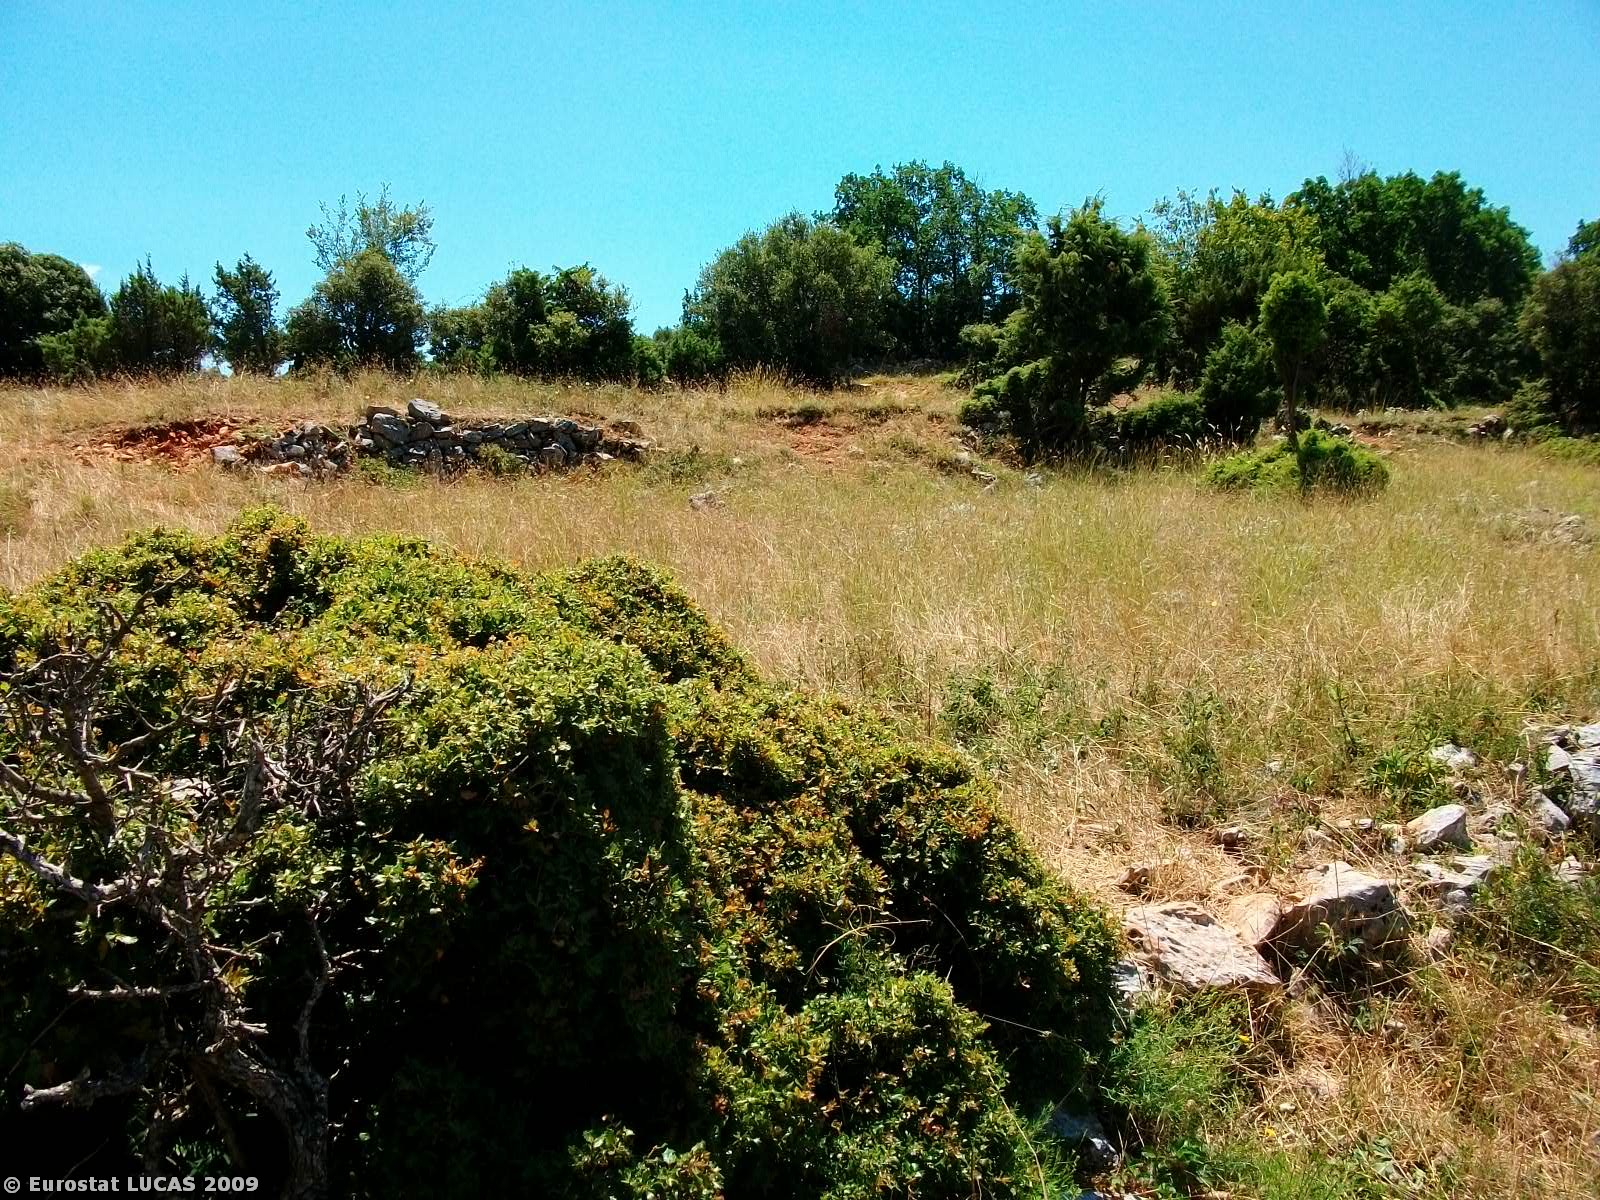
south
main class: Grassland
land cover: Grassland with sparse tree/shrub cover
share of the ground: > 75 %
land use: Agriculture (excluding fallow land and kitchen gardens)
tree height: < 5 m
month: May
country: GR
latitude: 41.0554
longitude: 24.3694
